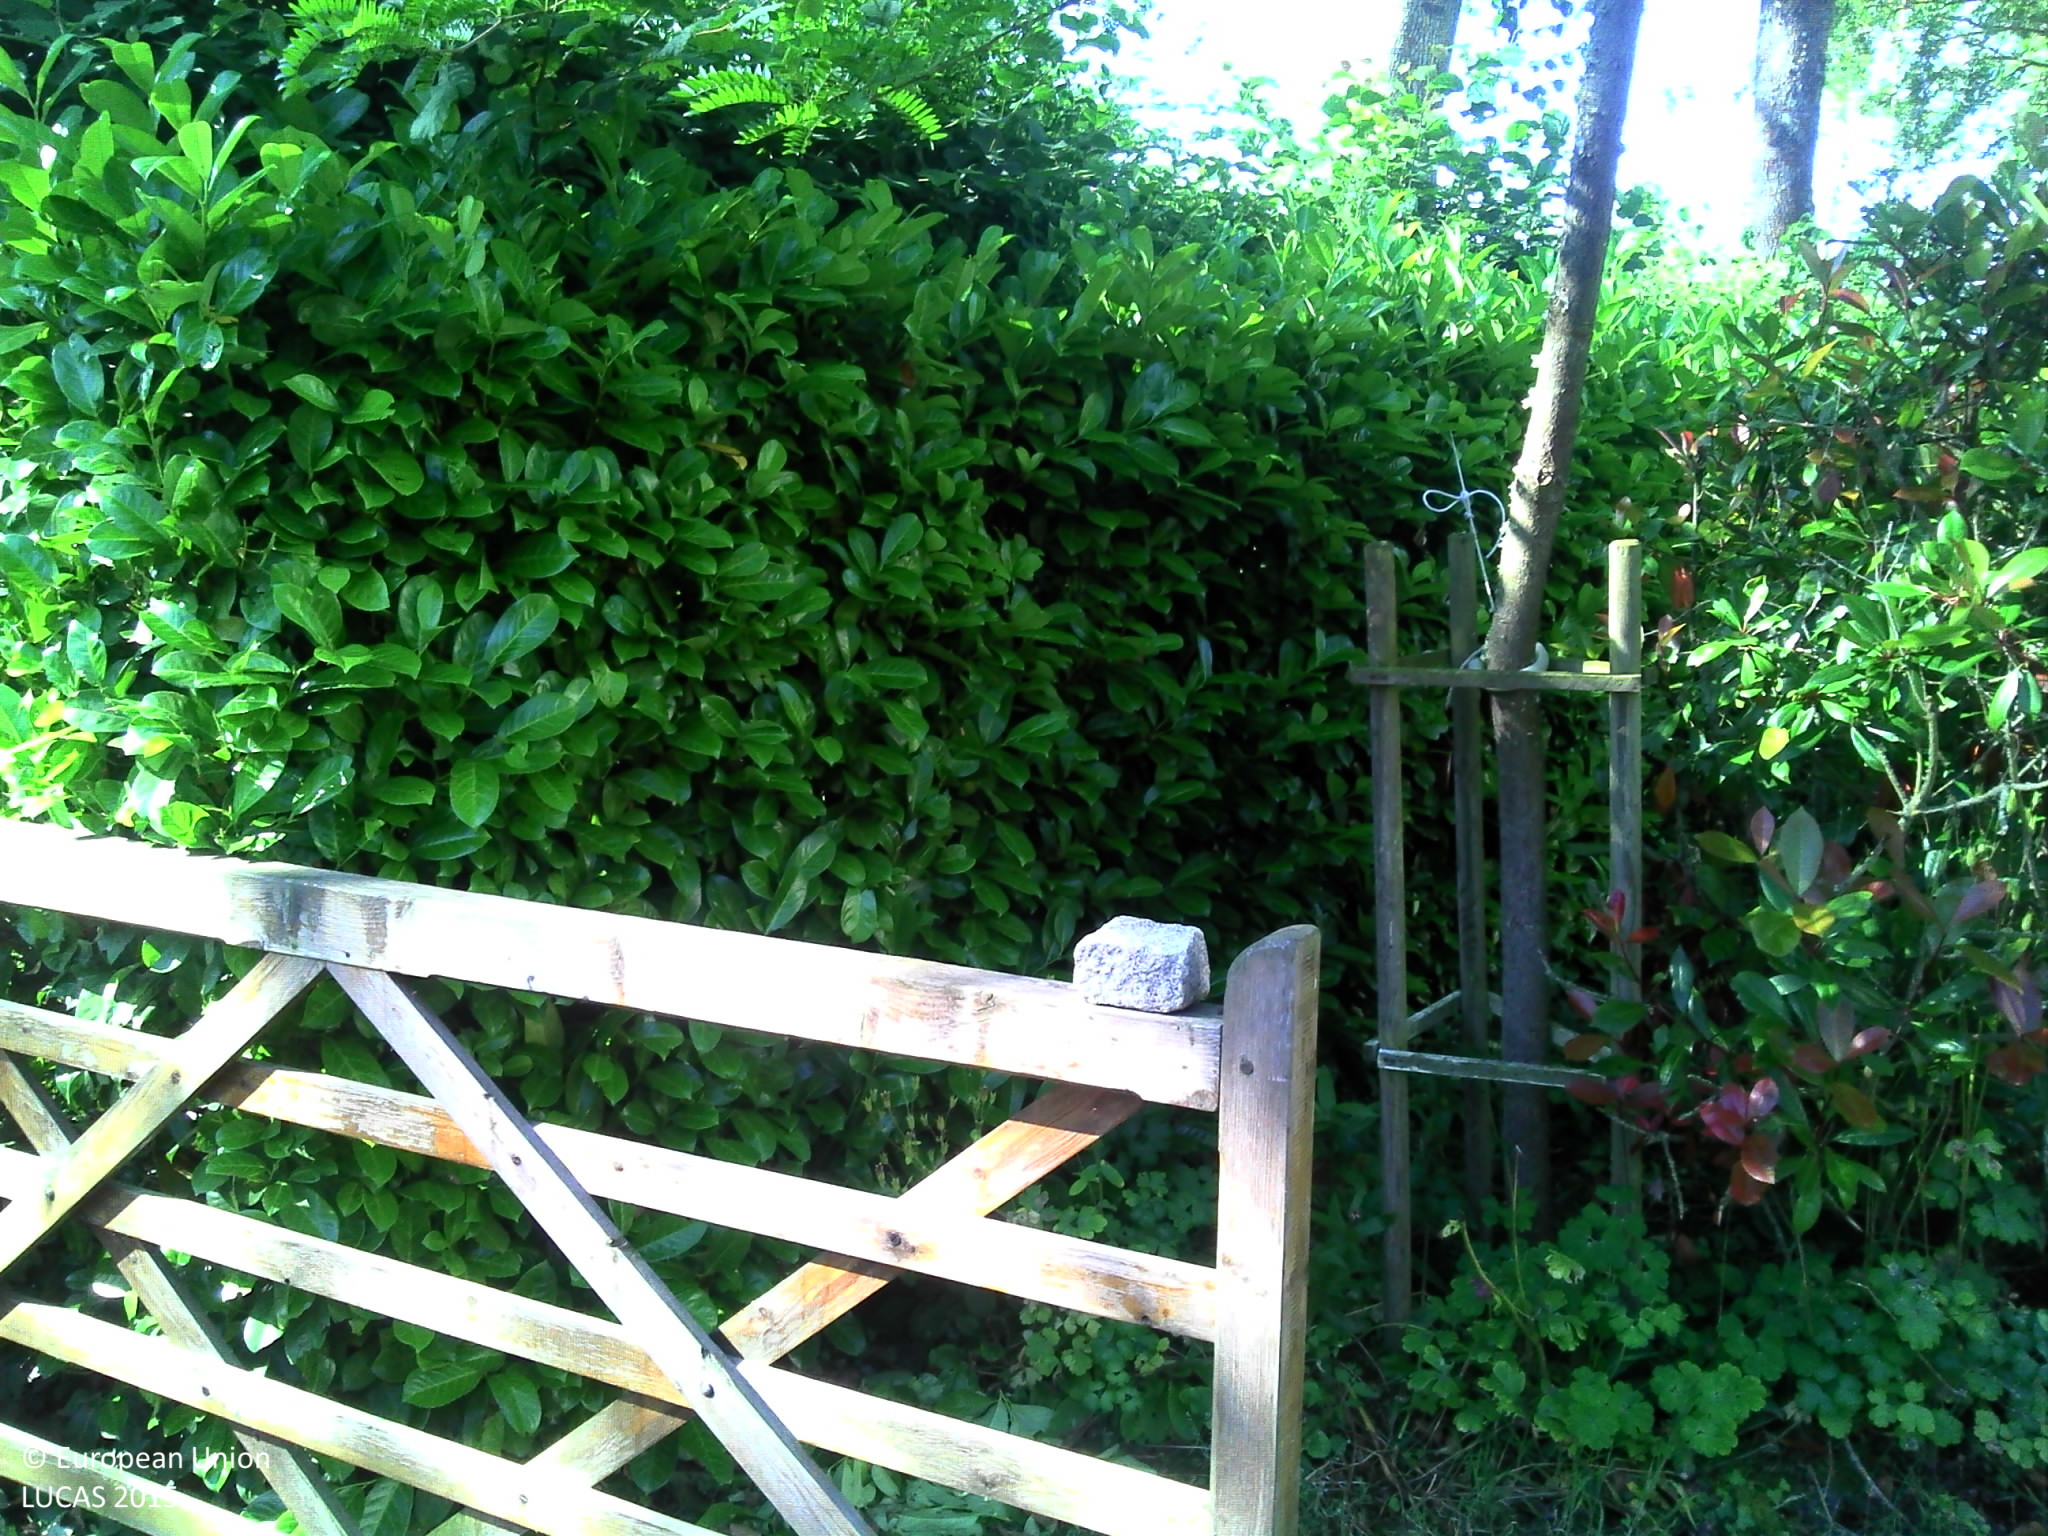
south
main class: Grassland
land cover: Grassland without tree/shrub cover
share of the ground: > 75 %
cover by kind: herbaceous plants 100 %
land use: Residential
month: July
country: FR
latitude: 48.9724
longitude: 0.5069
